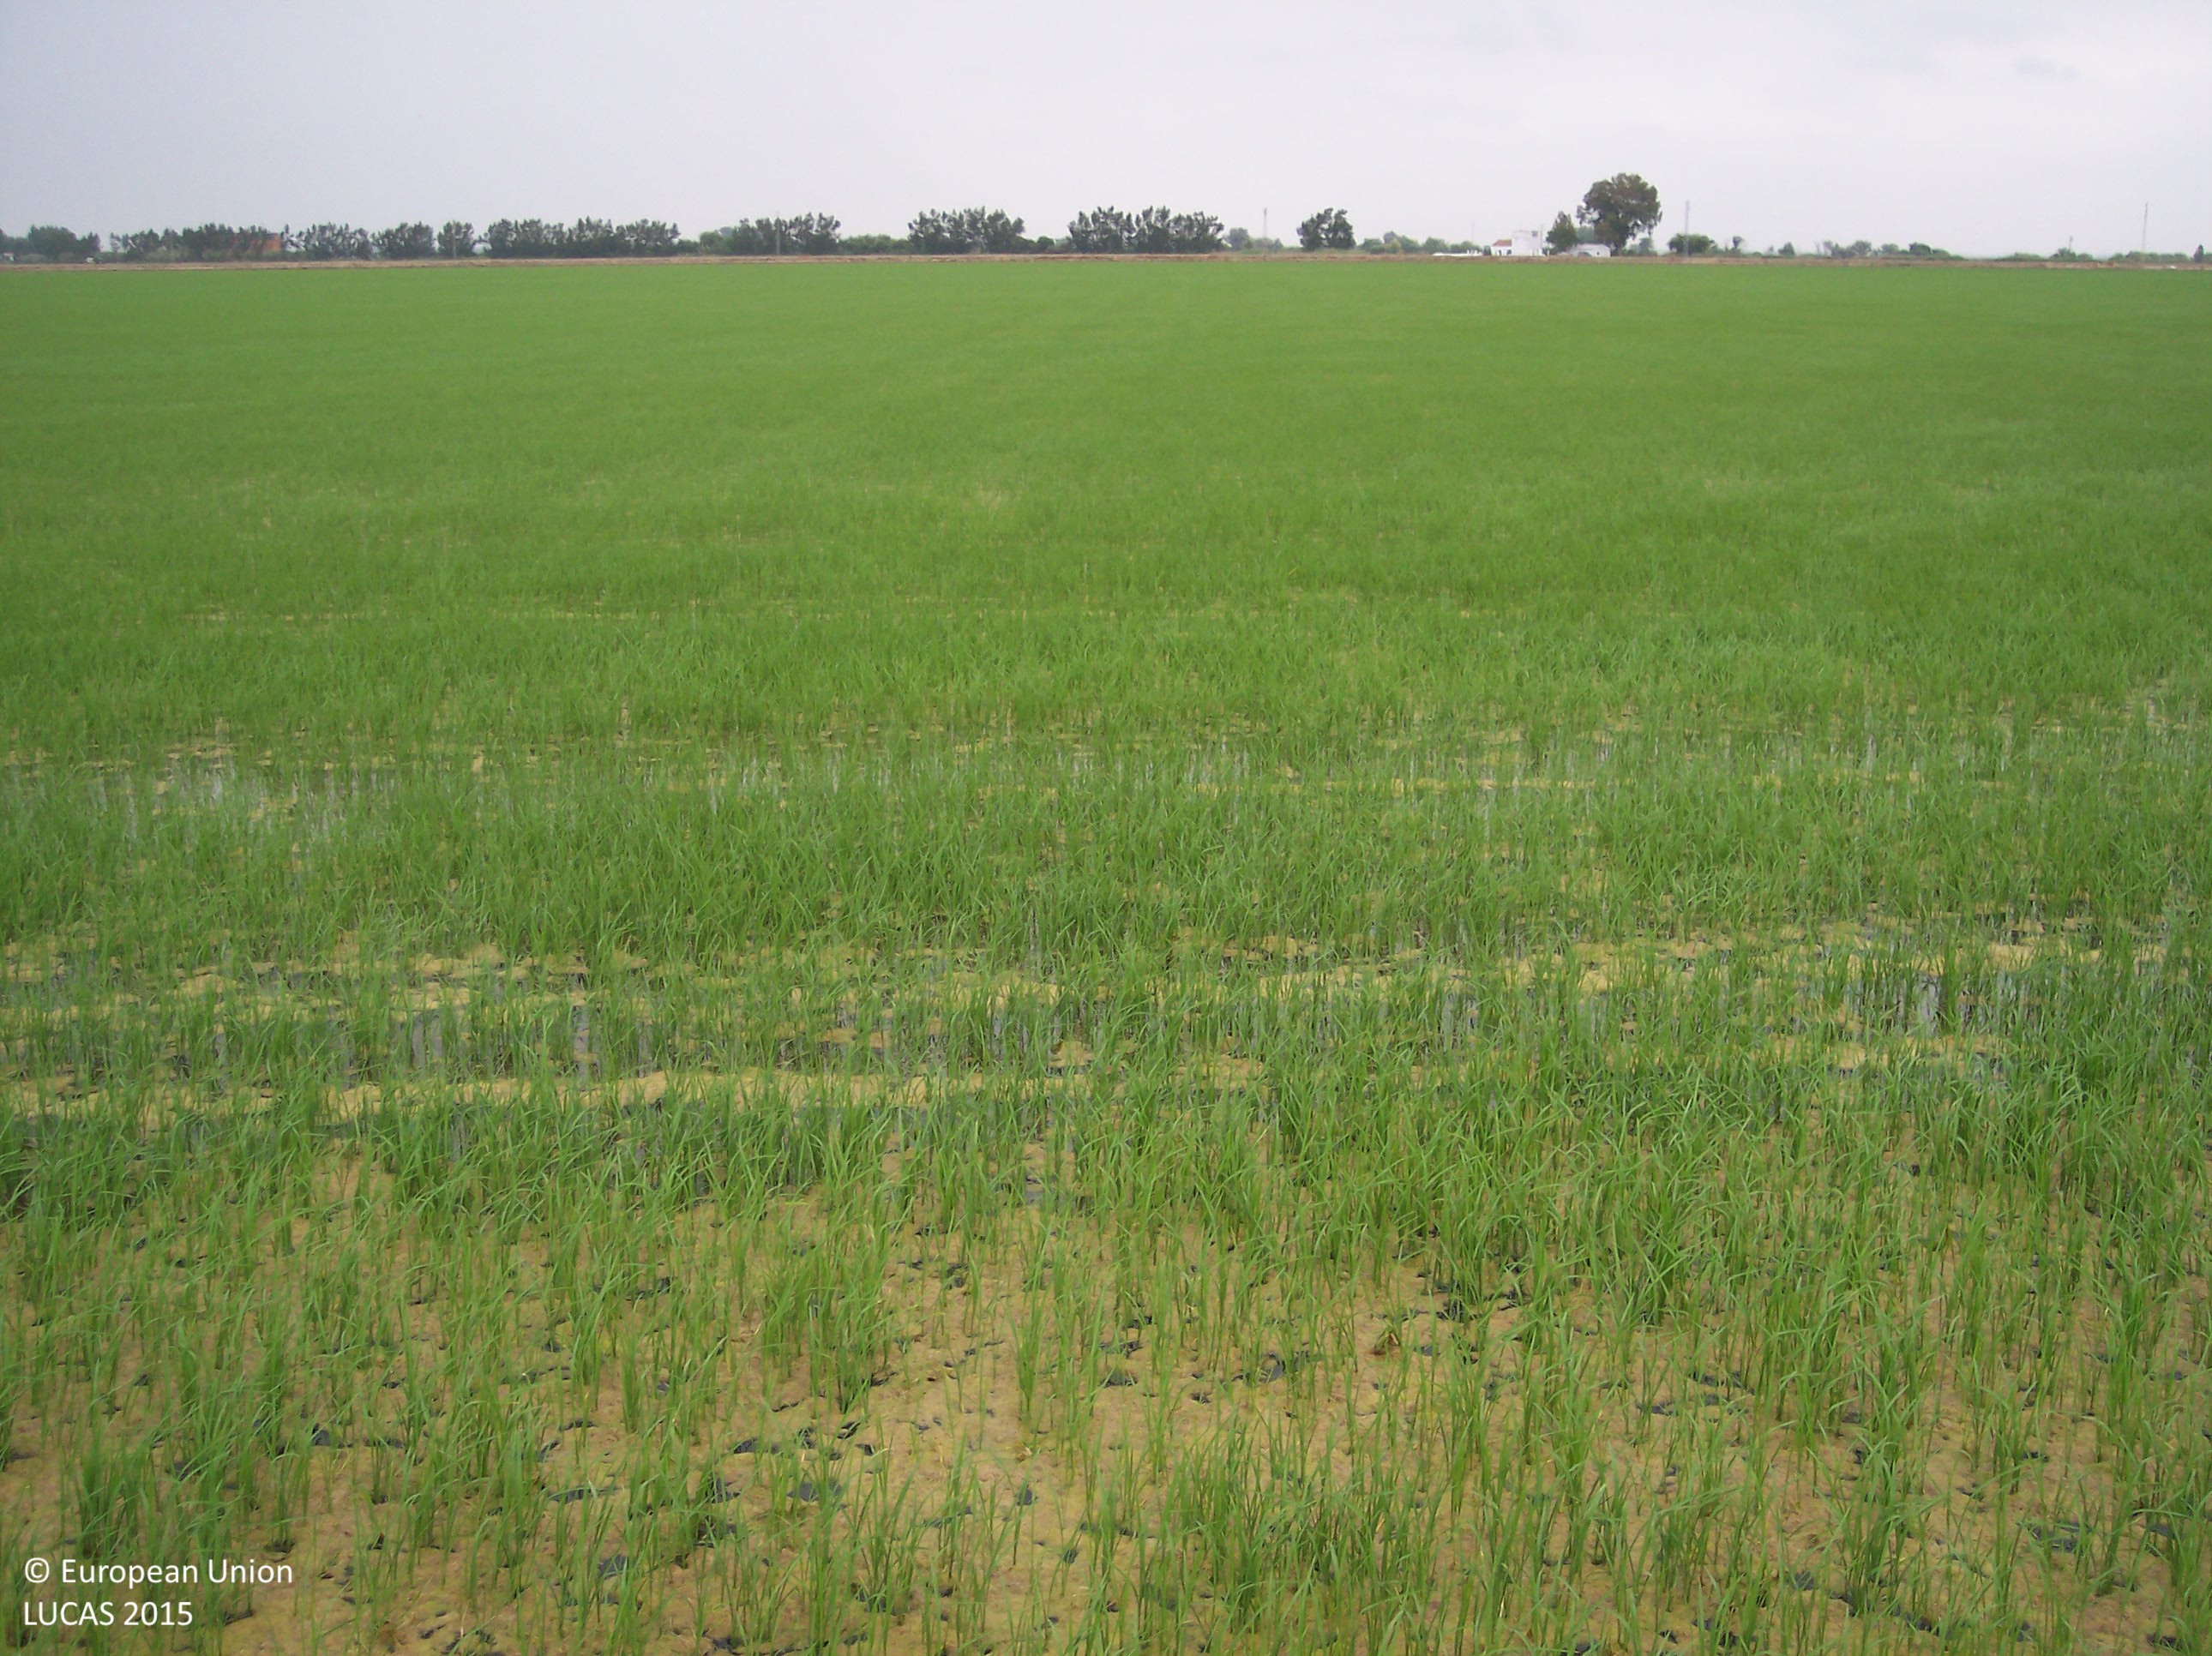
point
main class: Cropland
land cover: Rice
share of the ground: > 75 %
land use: Agriculture (excluding fallow land and kitchen gardens)
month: June
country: ES
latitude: 37.1570
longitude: -6.1120
